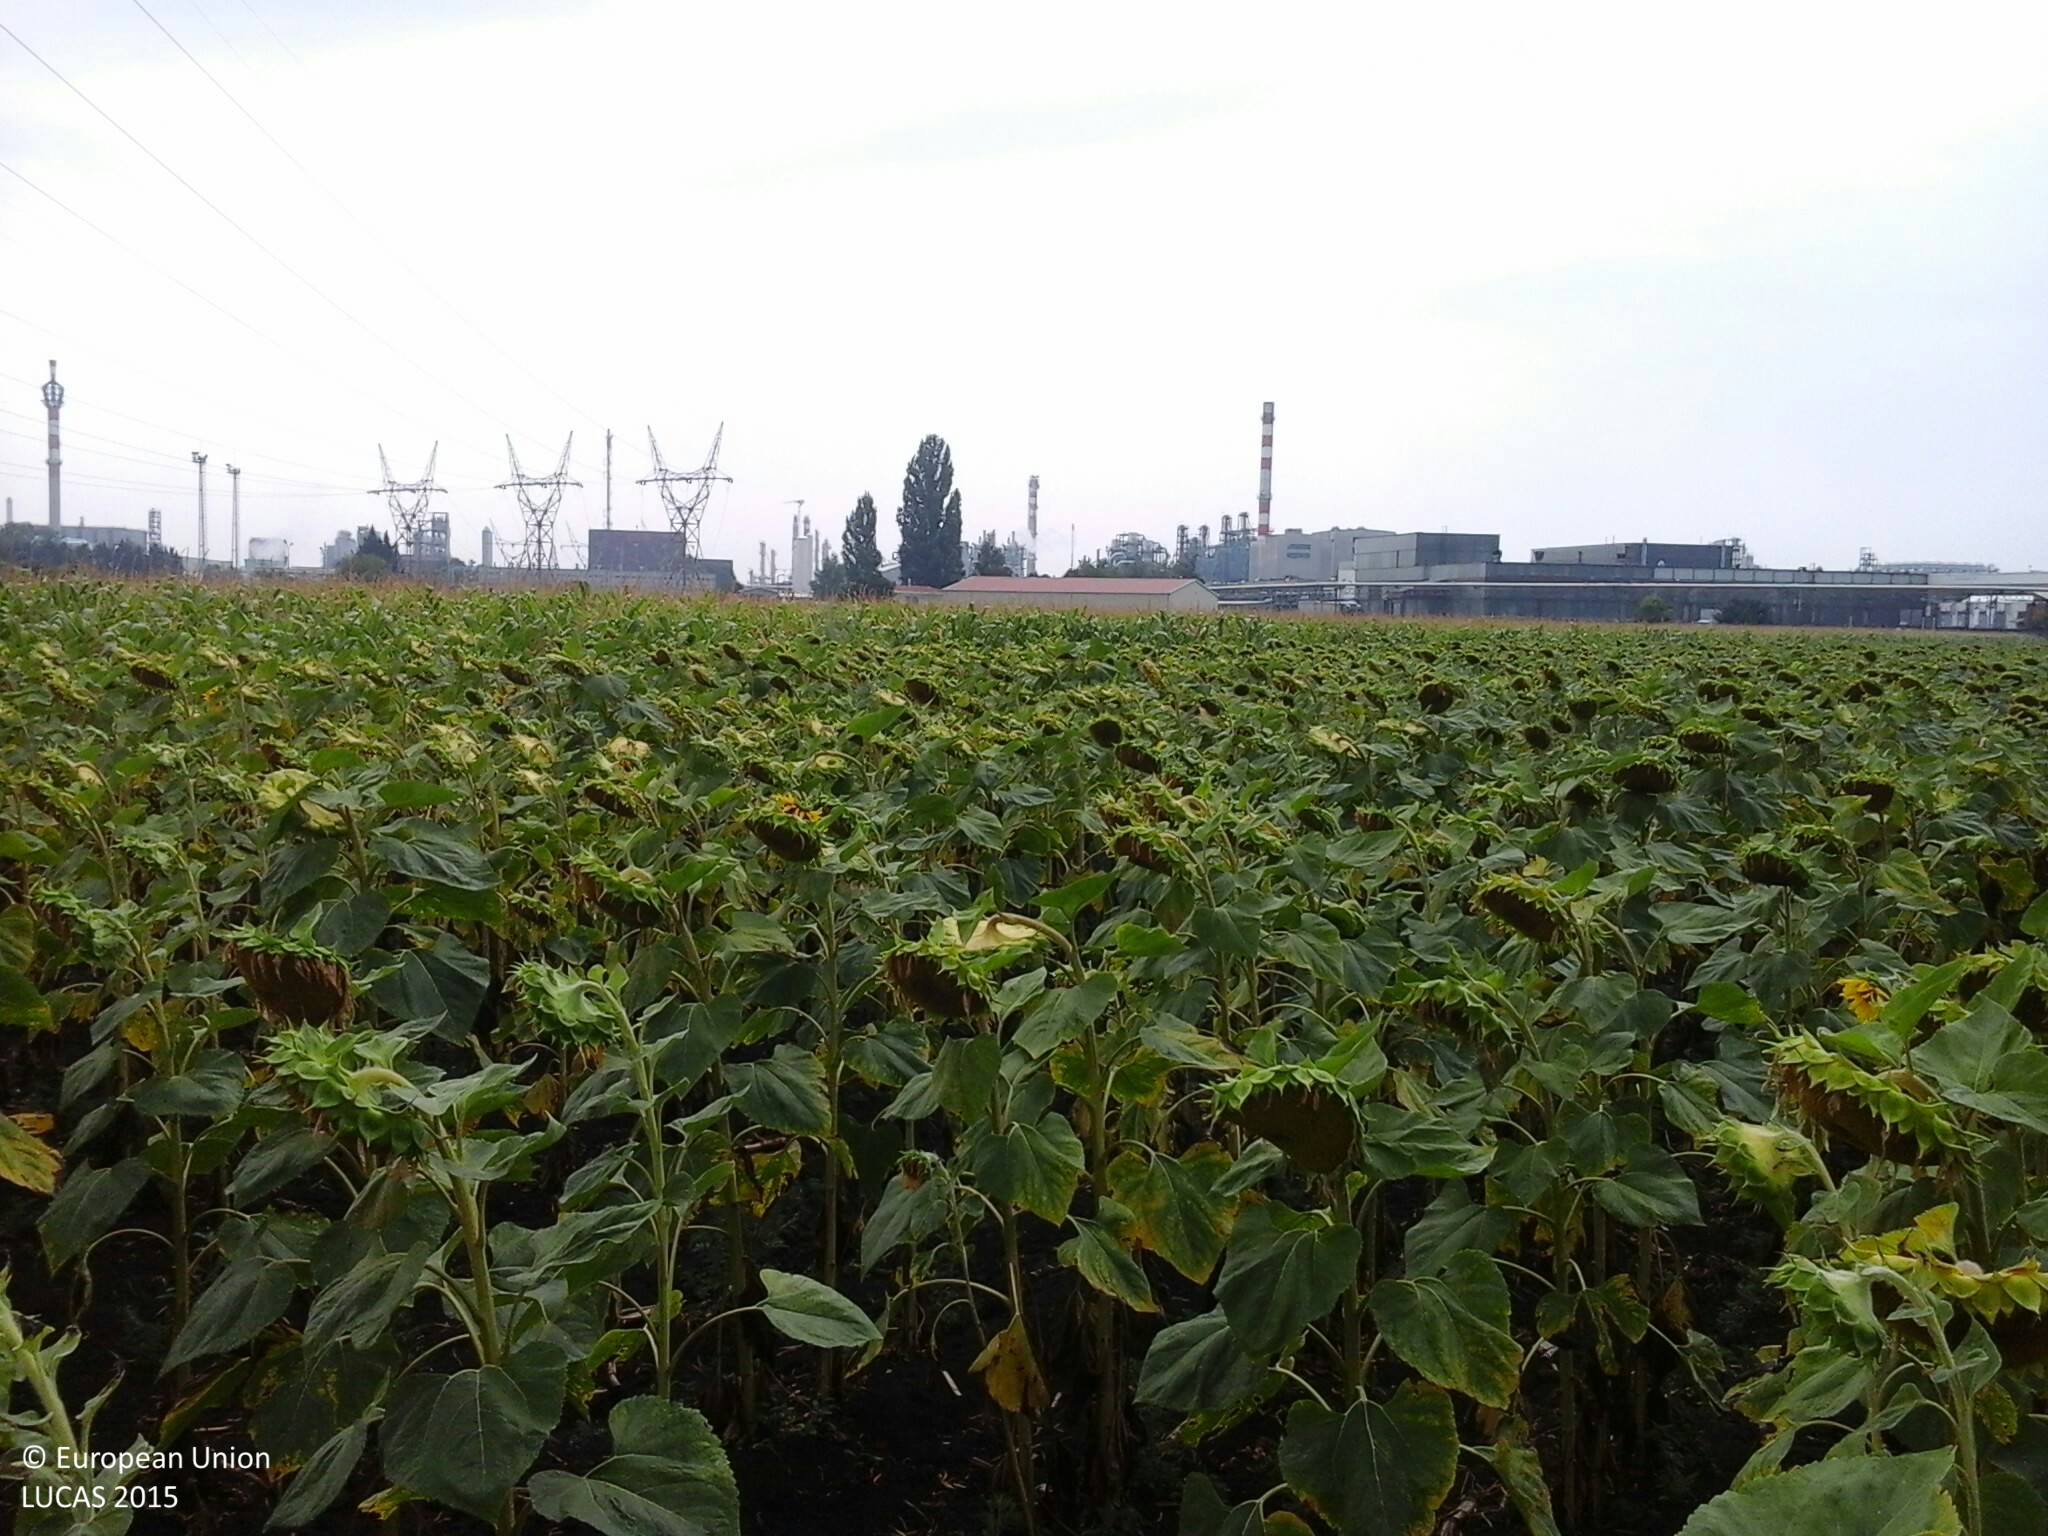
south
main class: Cropland
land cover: Sunflower
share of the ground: > 75 %
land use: Agriculture (excluding fallow land and kitchen gardens)
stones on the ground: < 10 %
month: August
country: HU
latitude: 47.9229
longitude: 21.0260
